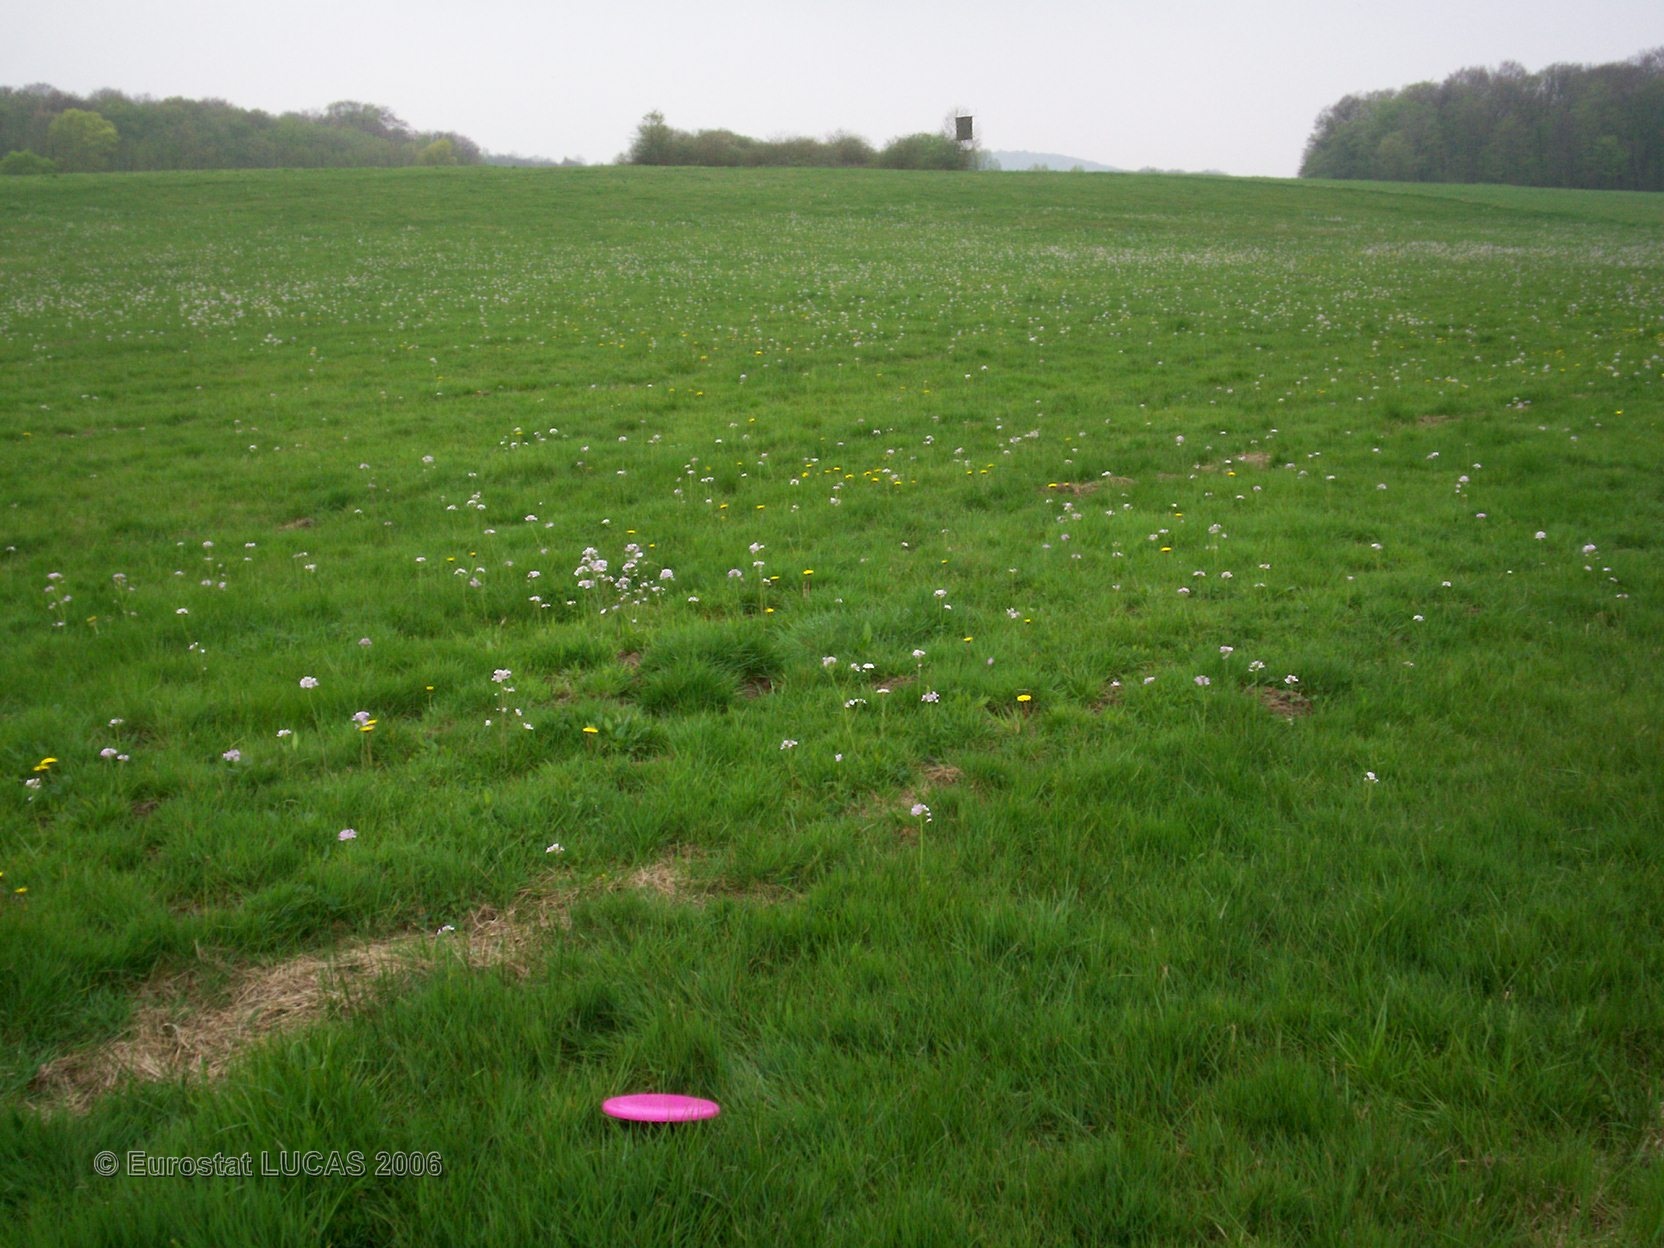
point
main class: Grassland
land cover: Grassland without tree/shrub cover
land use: Agriculture (excluding fallow land and kitchen gardens)
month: April
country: FR
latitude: 48.9136
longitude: 6.7391
